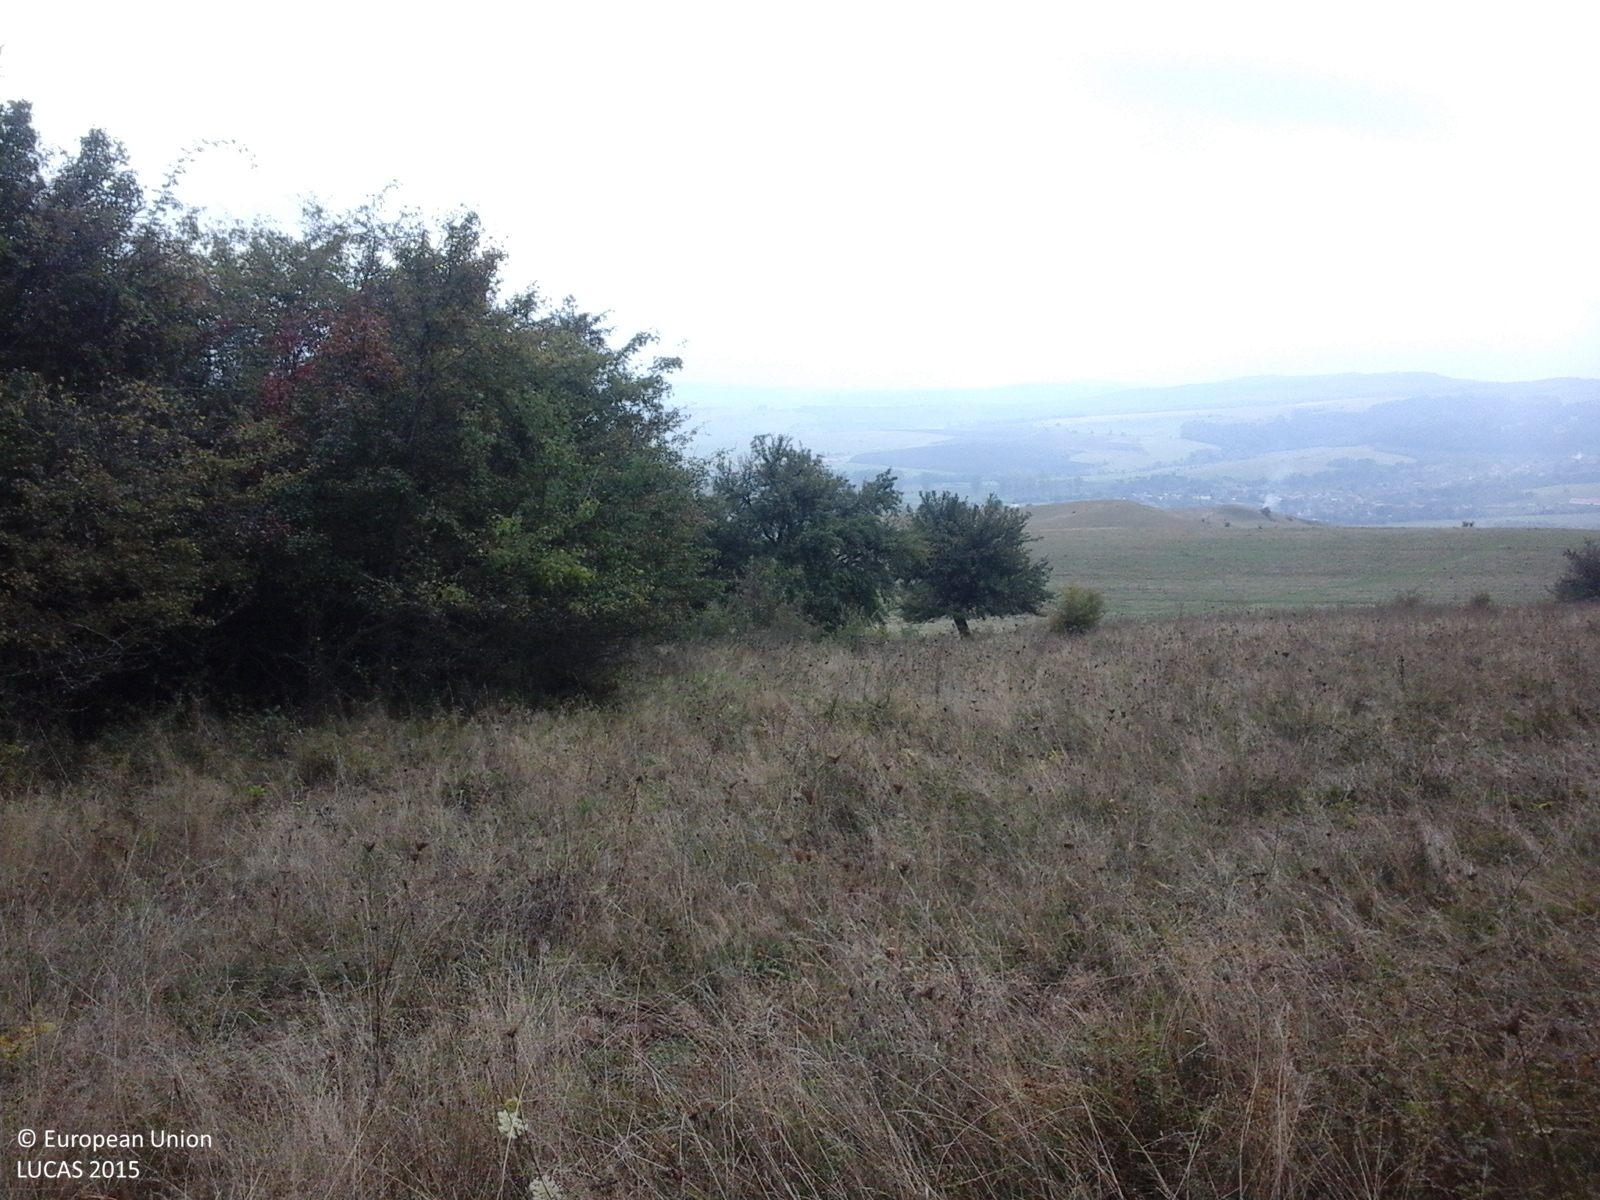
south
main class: Grassland
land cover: Grassland with sparse tree/shrub cover
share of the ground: > 75 %
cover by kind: herbaceous plants 85 %, shrubs 10 %, broadleaved forest trees 5 %
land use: Fallow land
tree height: < 5 m
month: October
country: RO
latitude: 46.0760
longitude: 25.1086
